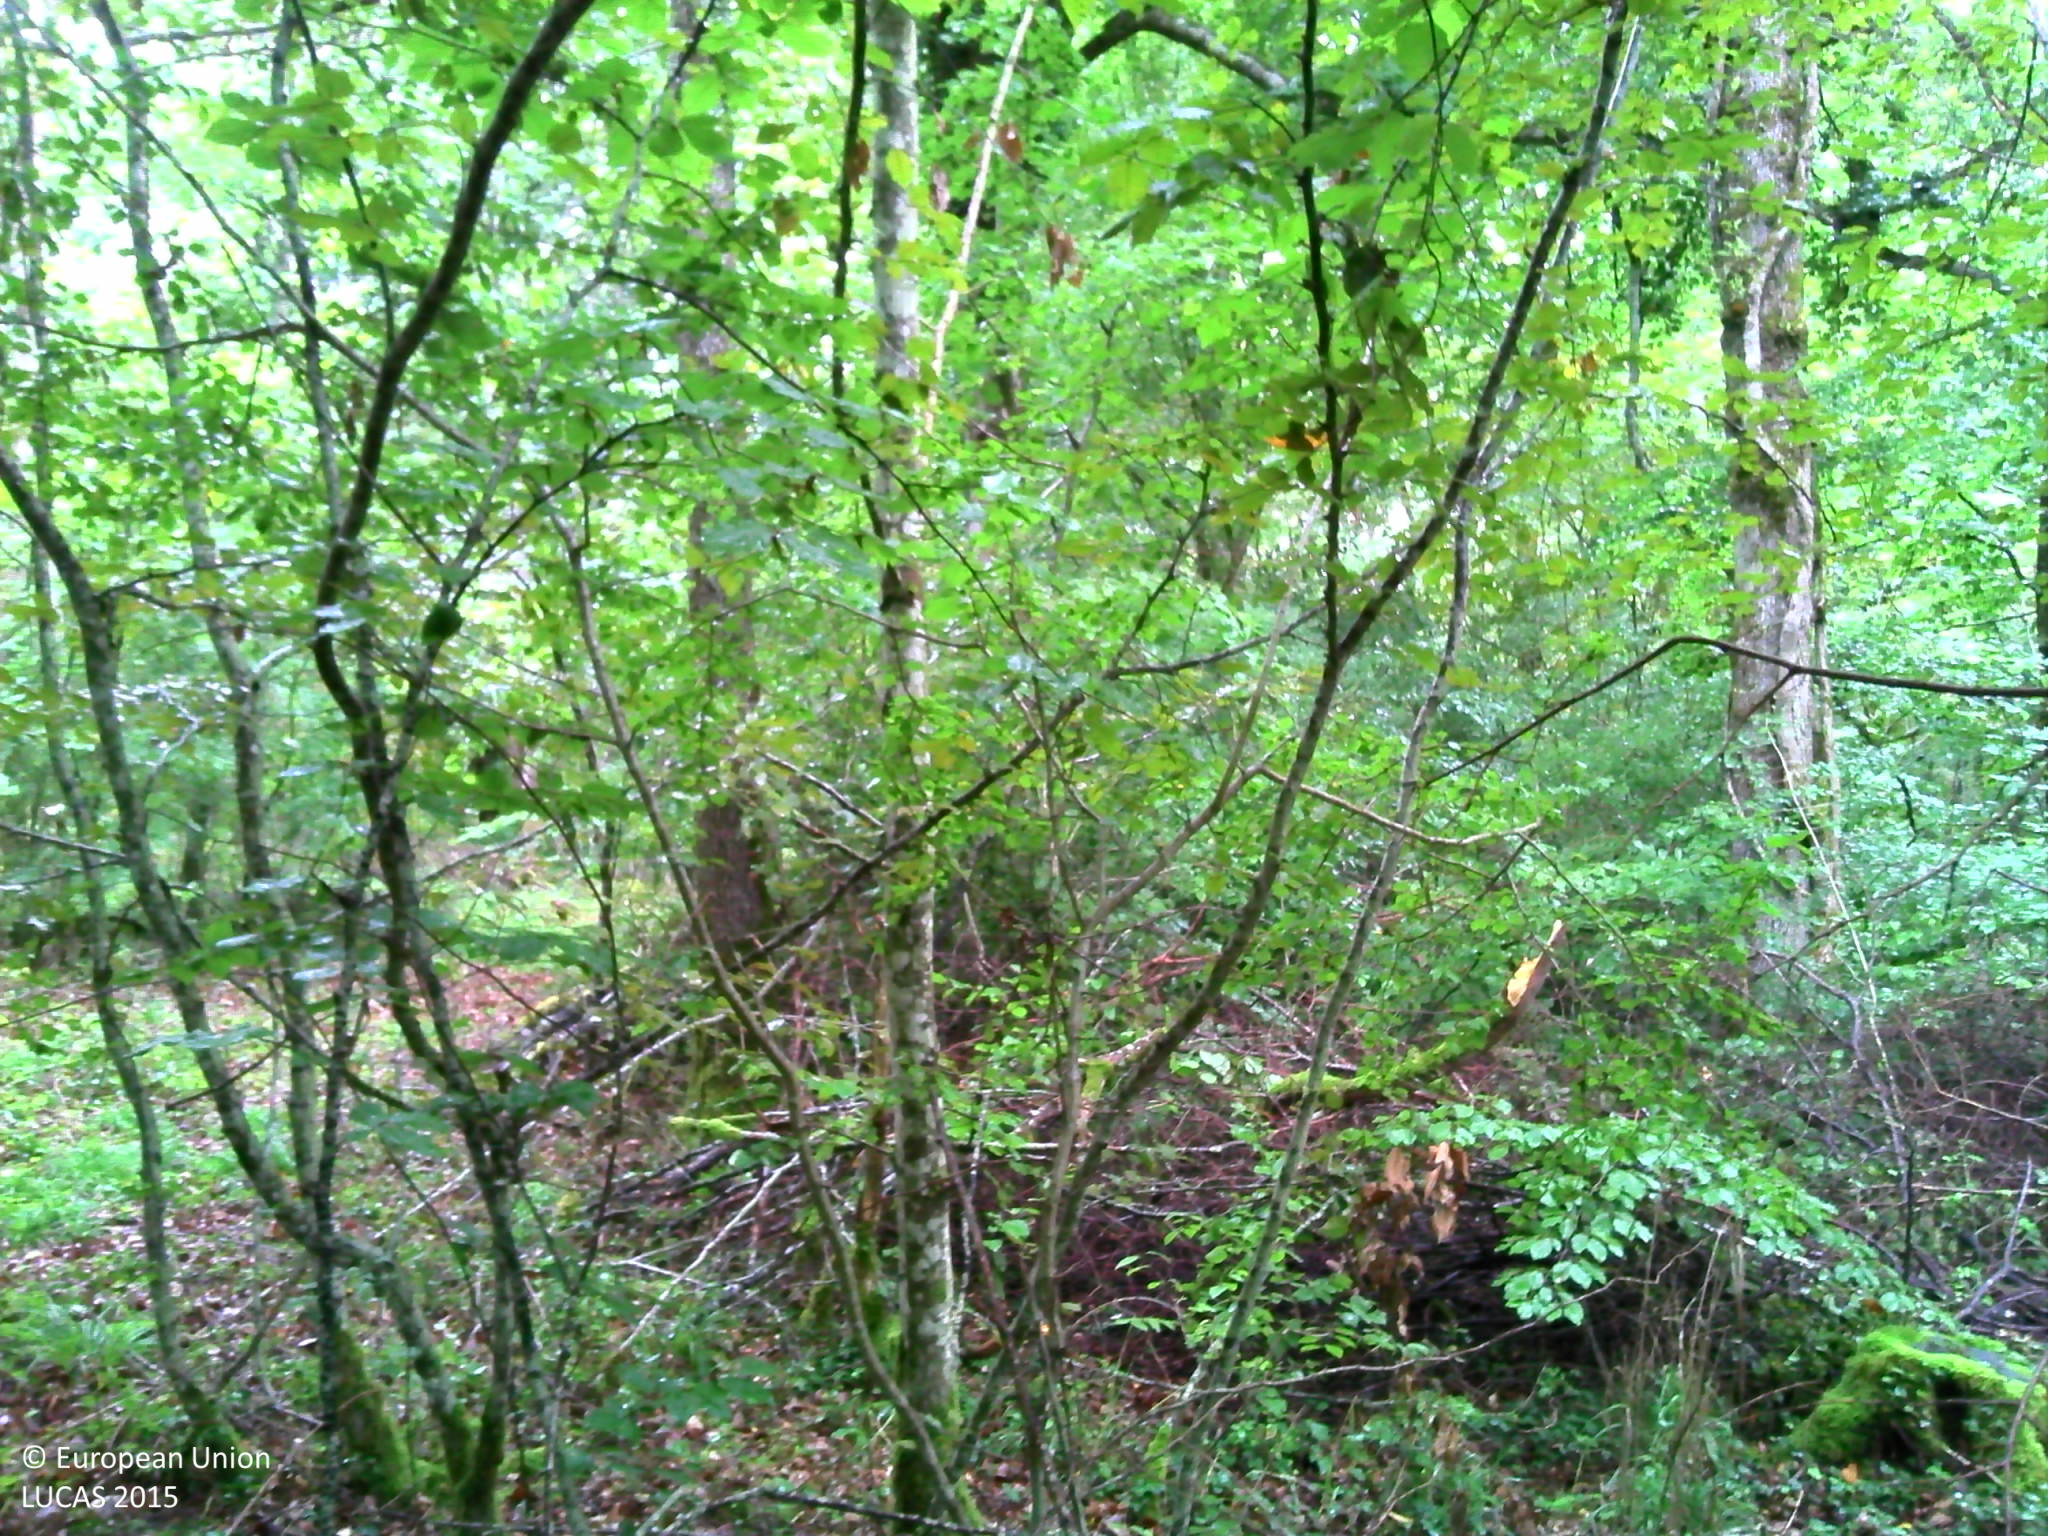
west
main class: Woodland
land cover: Broadleaved woodland
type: mesophytic deciduous forest
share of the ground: > 75 %
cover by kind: broadleaved forest trees 80 %, herbaceous plants 15 %, shrubs 5 %
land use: Forestry
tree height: > 5 m
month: September
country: FR
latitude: 47.1266
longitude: 4.7935
